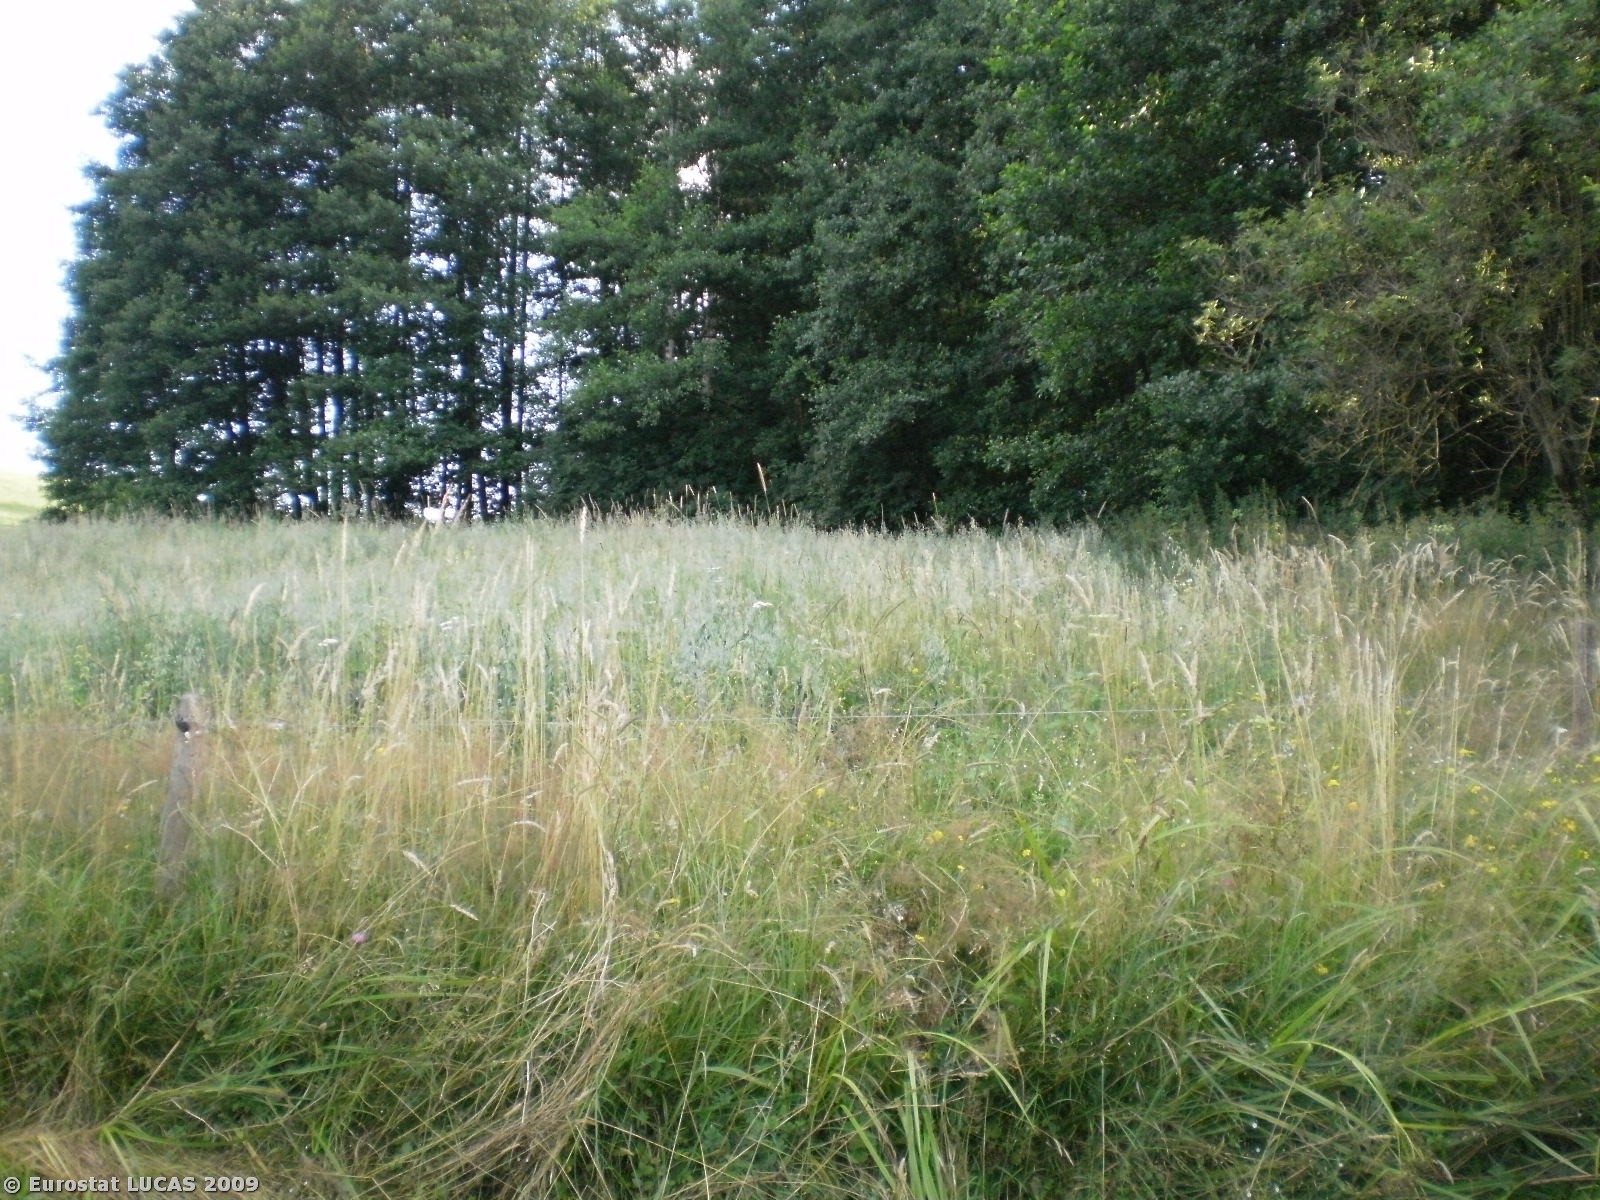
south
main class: Grassland
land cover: Grassland with sparse tree/shrub cover
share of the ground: > 75 %
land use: Agriculture (excluding fallow land and kitchen gardens)
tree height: < 5 m
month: July
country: PL
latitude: 53.9921
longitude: 20.5462
